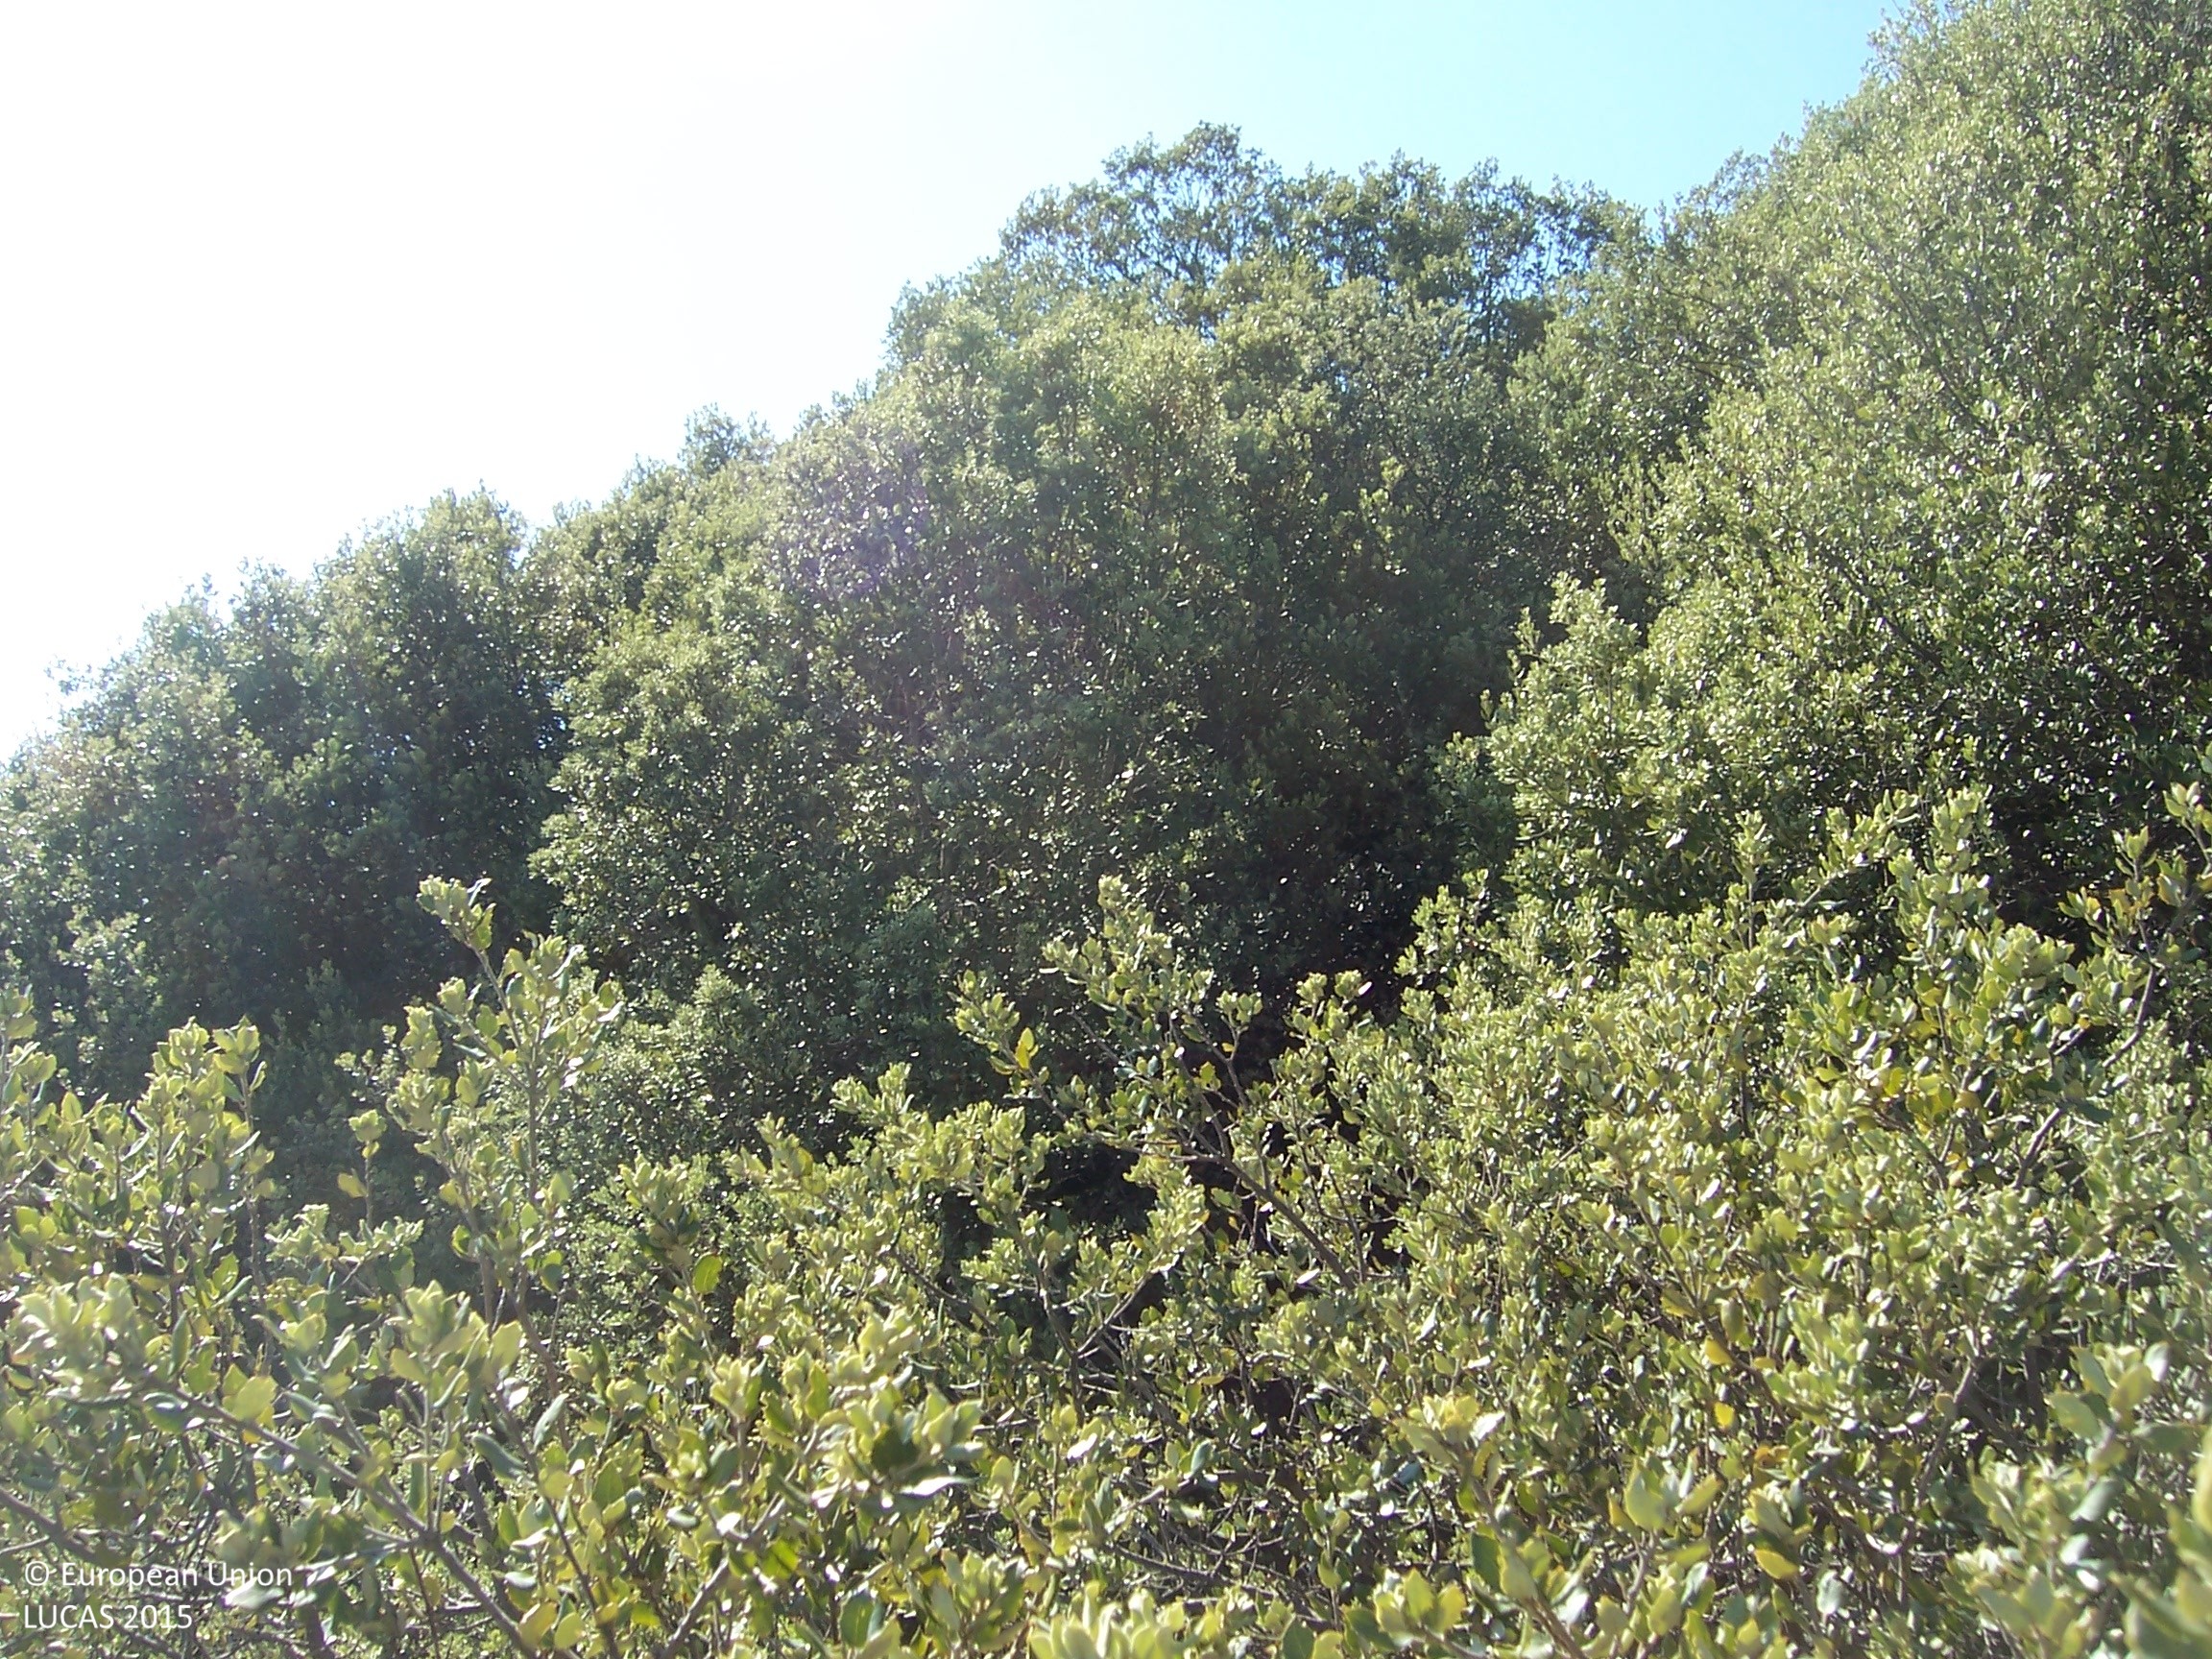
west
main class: Woodland
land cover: Broadleaved woodland
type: broadleaved evergreen forest
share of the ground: 25 - 50 %
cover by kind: broadleaved forest trees 30 %, shrubs 30 %, herbaceous plants 30 %, unconsolidated bare surface 10 %
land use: Semi-natural and natural areas not in use
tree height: < 5 m
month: August
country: ES
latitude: 42.2799
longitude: 0.3164
